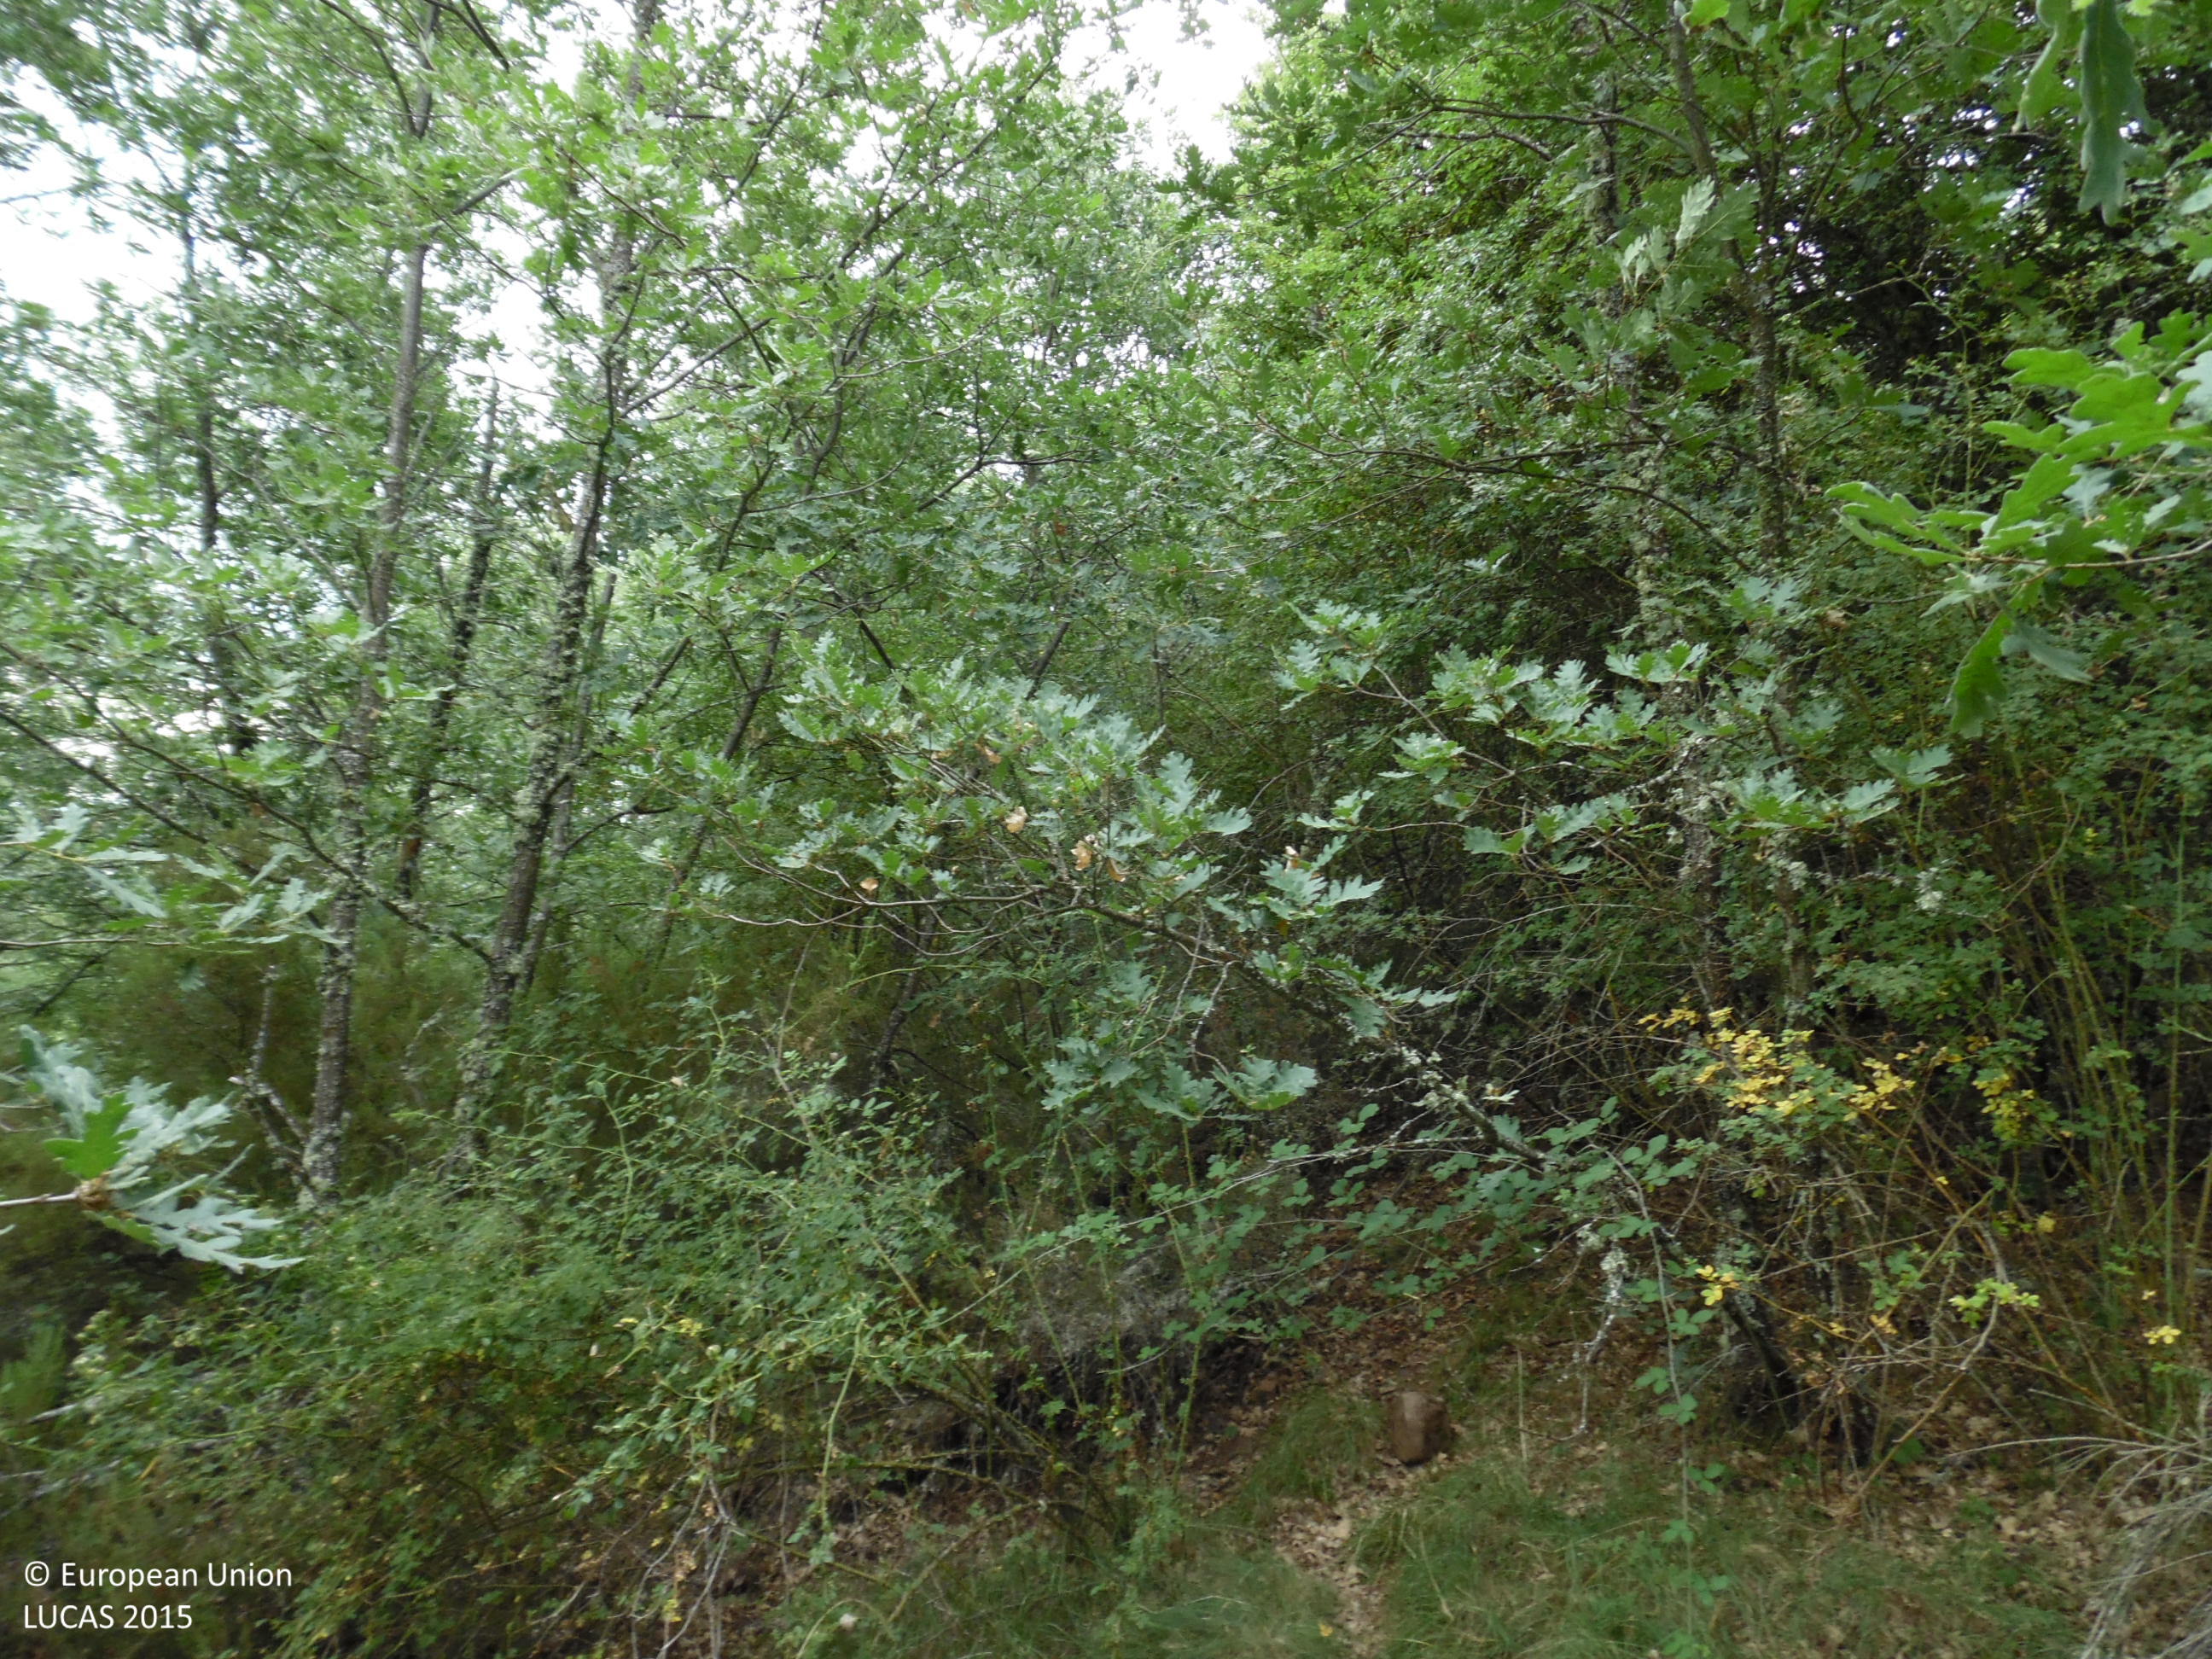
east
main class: Woodland
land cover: Broadleaved woodland
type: thermophilous deciduous forest
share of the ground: > 75 %
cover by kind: broadleaved forest trees 95 %, shrubs 5 %
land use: Forestry
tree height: > 5 m
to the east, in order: Broadleaved woodland
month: July
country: ES
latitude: 42.7199
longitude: -5.8450
